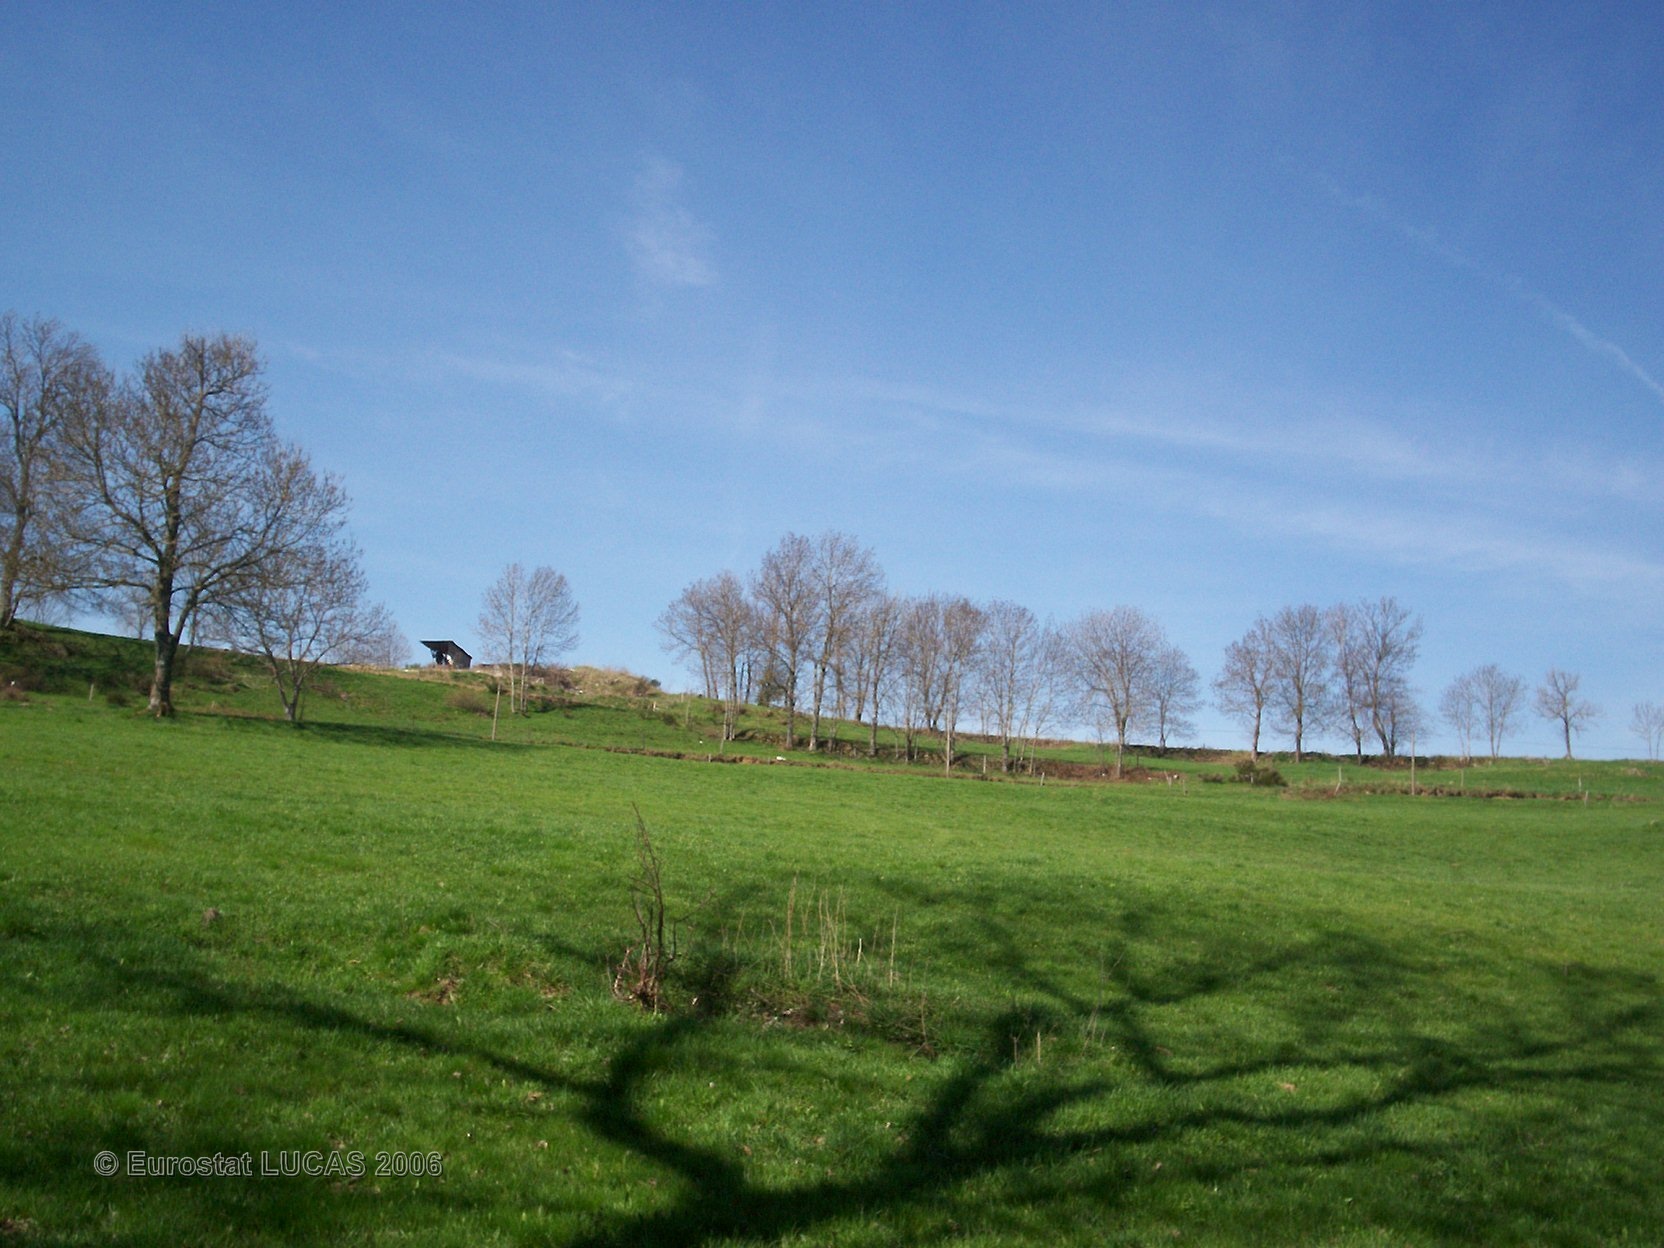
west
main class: Grassland
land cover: Grassland without tree/shrub cover
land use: Agriculture (excluding fallow land and kitchen gardens)
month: April
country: FR
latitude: 45.1817
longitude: 4.1884
